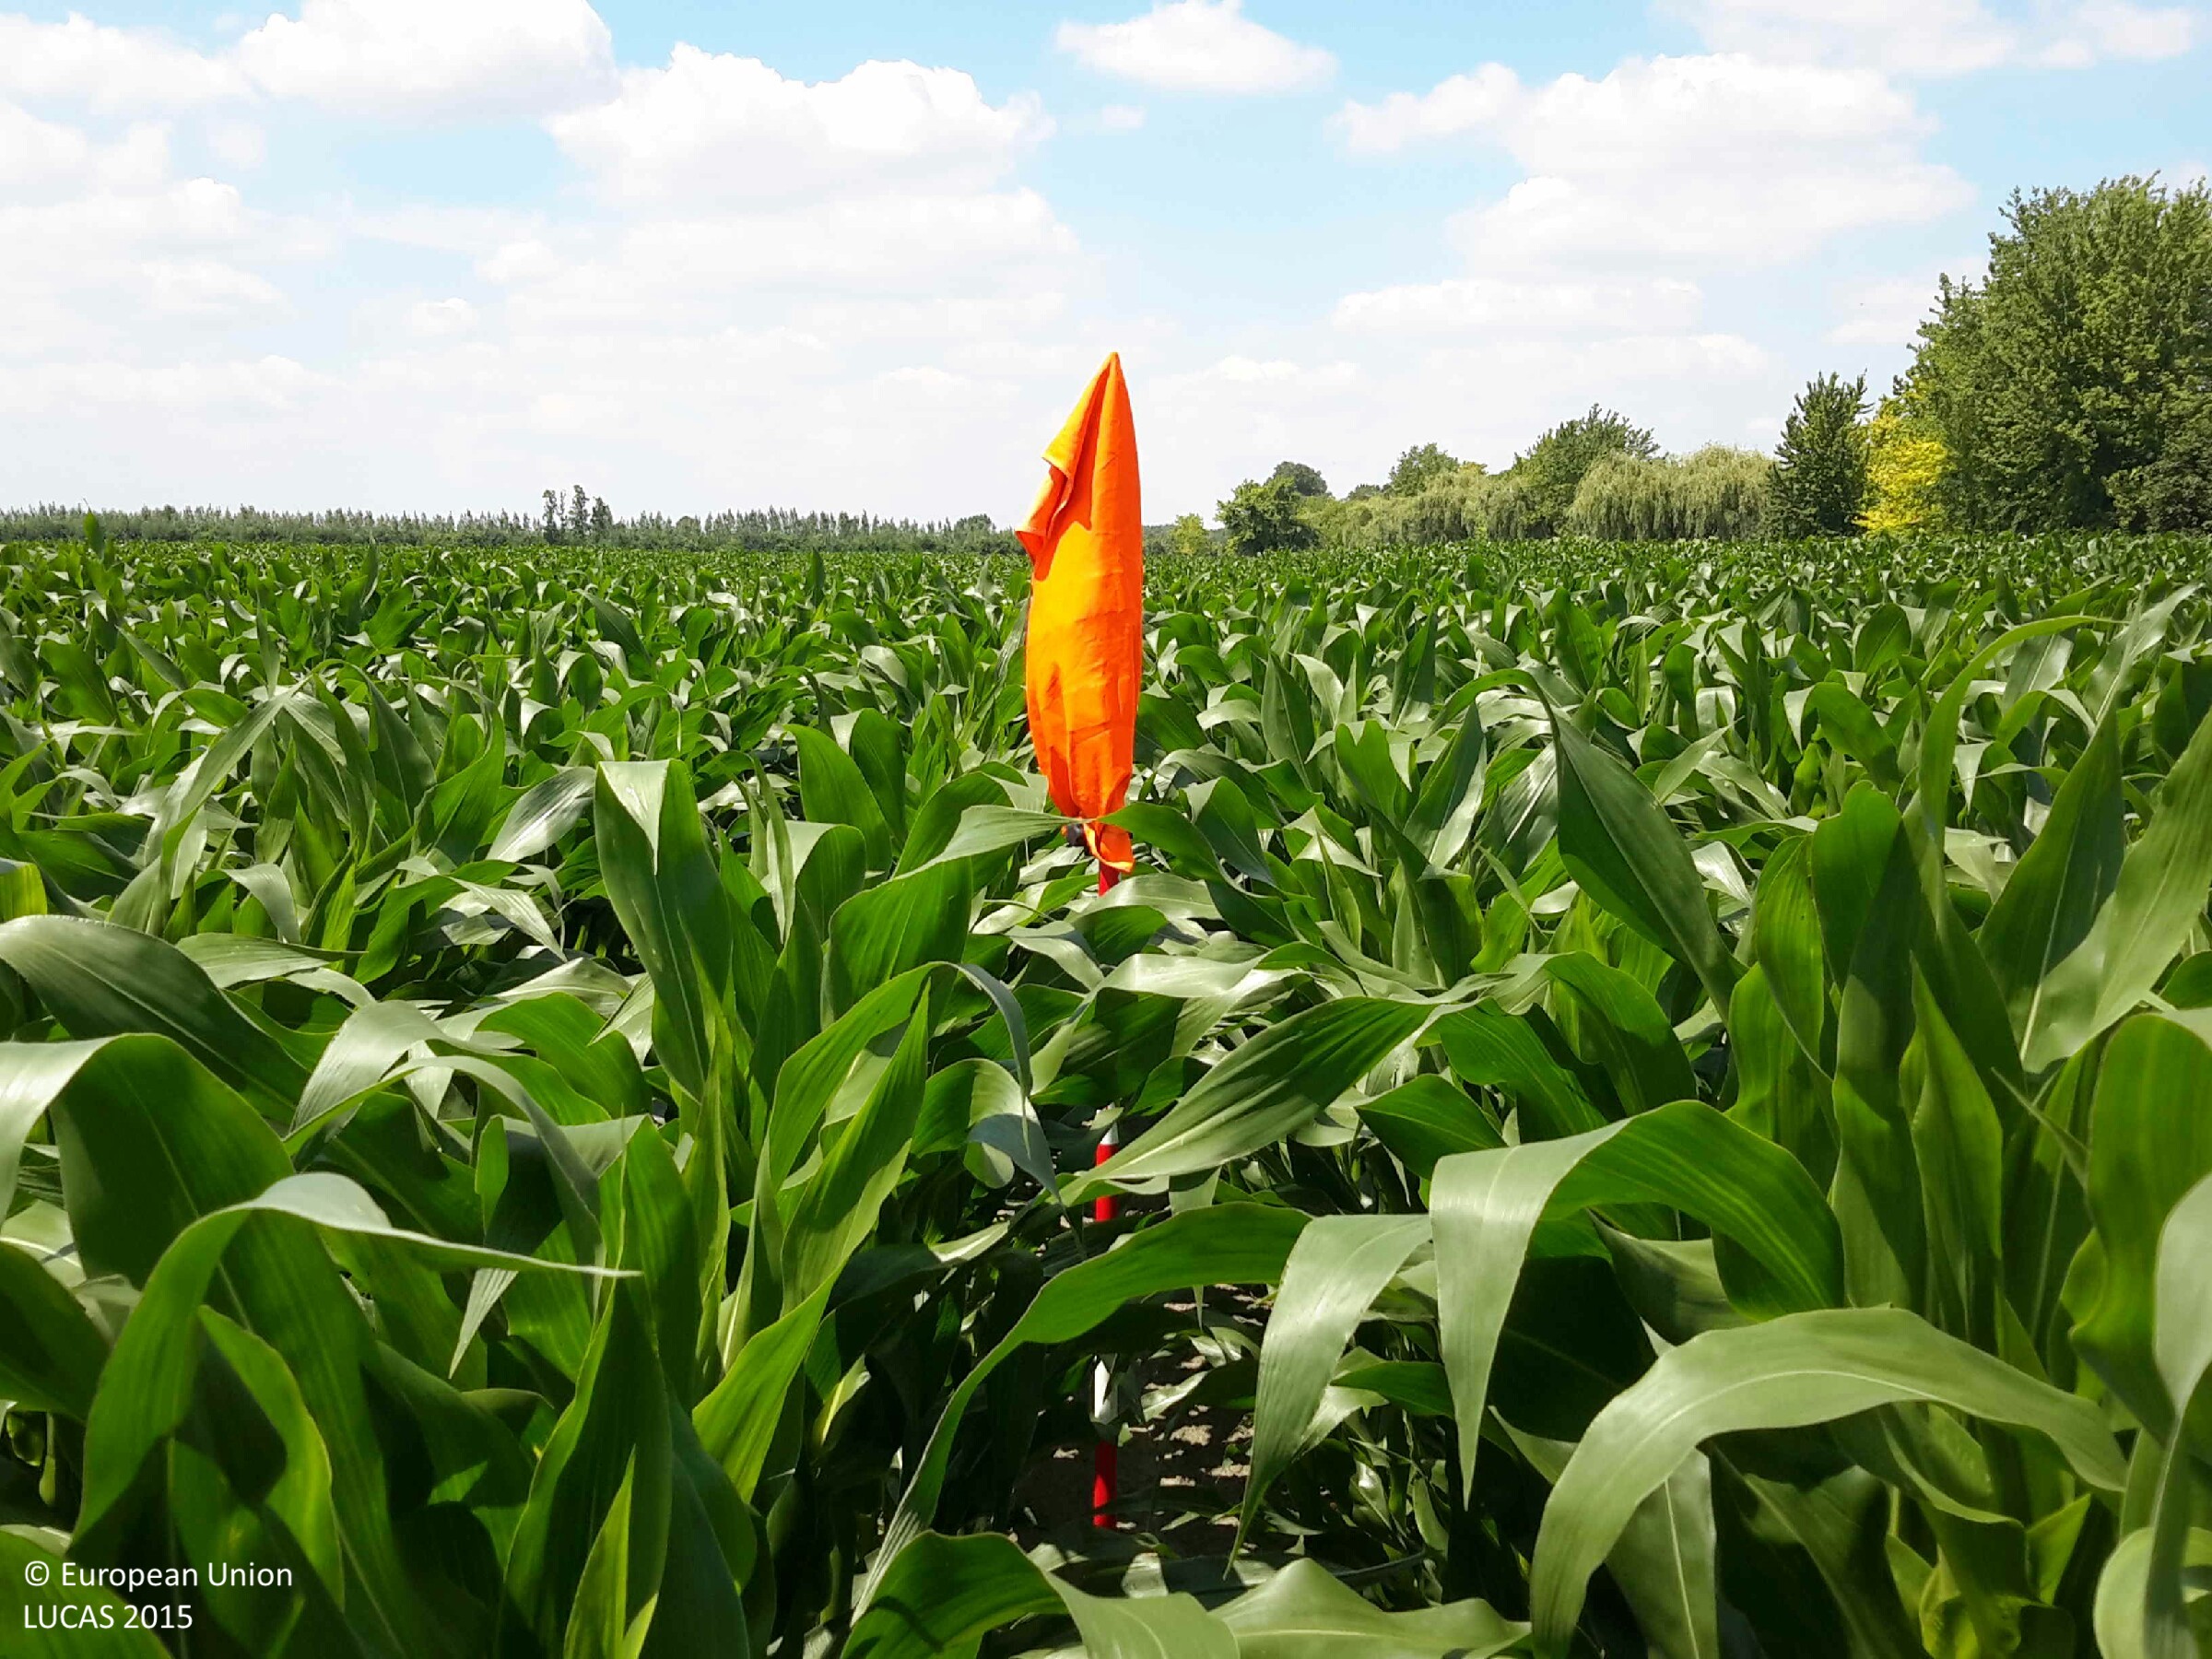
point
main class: Cropland
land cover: Maize
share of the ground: > 75 %
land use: Agriculture (excluding fallow land and kitchen gardens)
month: June
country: HU
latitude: 47.7140
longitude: 17.5131
